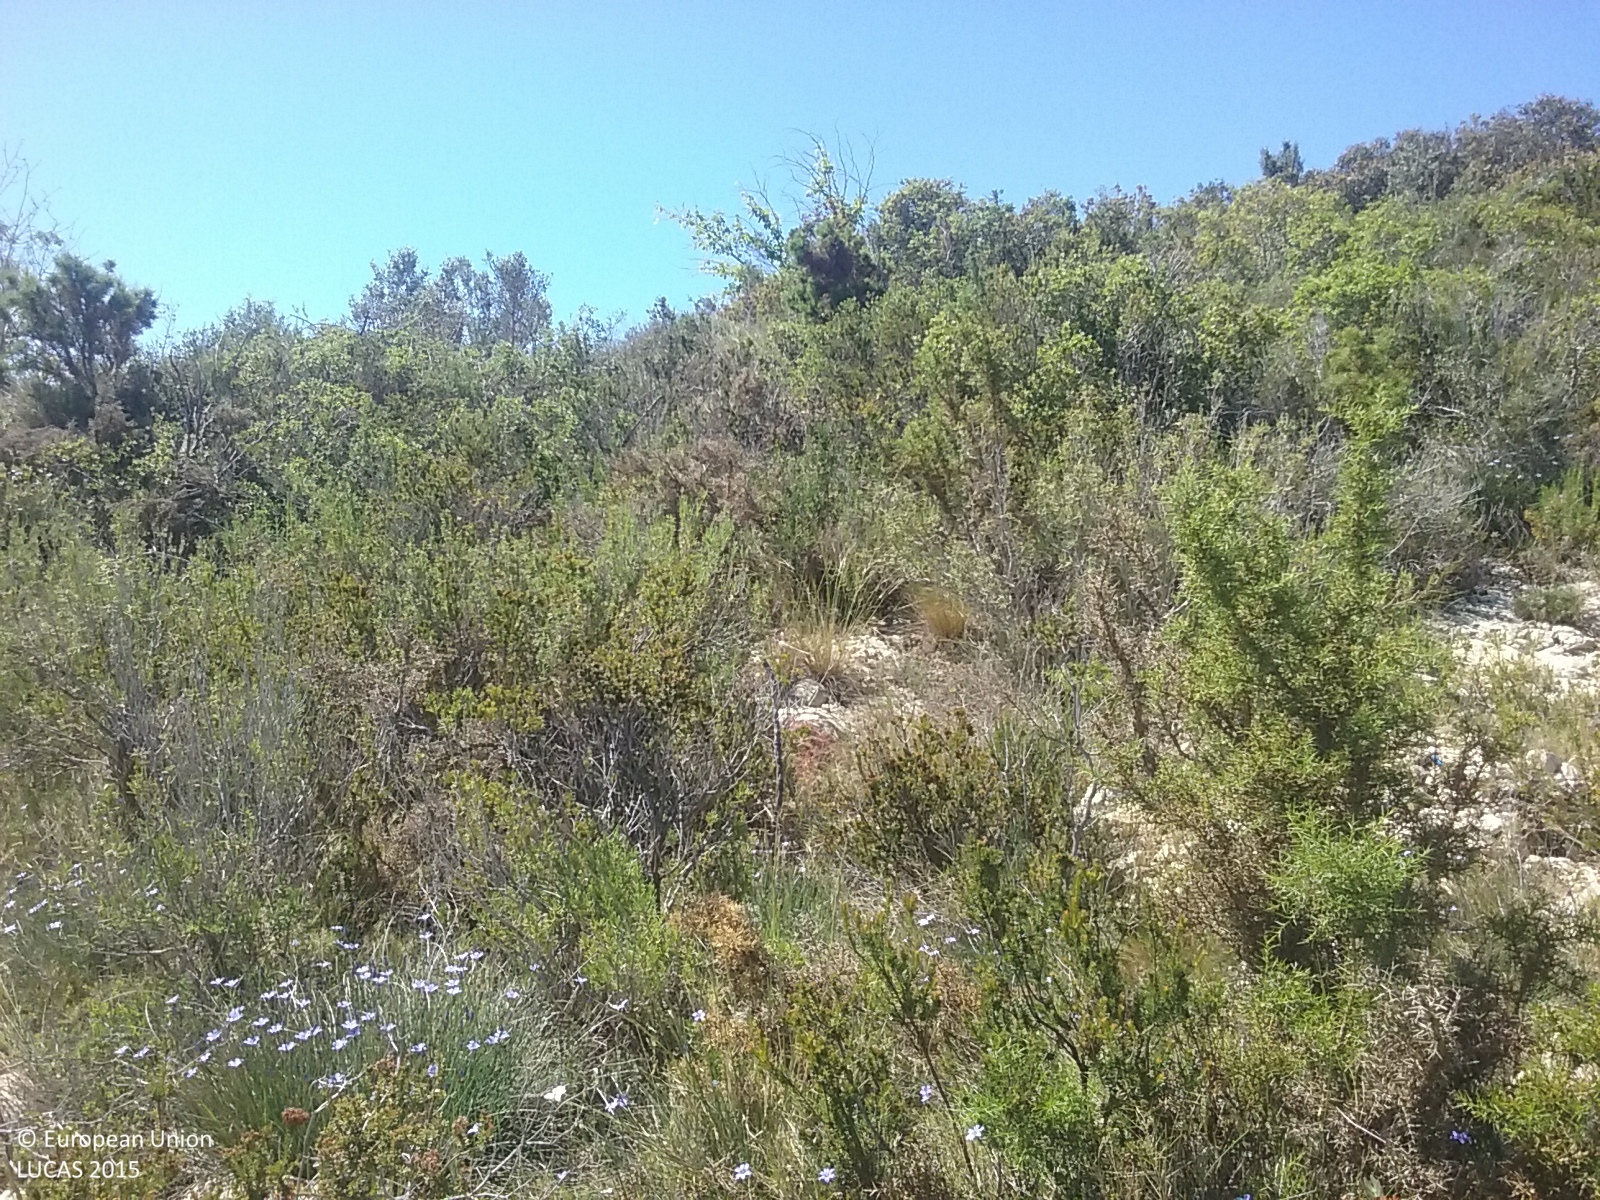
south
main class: Shrubland
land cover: Shrubland with sparse tree cover
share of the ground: 50 - 75 %
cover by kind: shrubs 70 %, coniferous forest trees 5 %
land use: Semi-natural and natural areas not in use
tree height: < 5 m
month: May
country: ES
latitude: 40.4046
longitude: 0.2990
